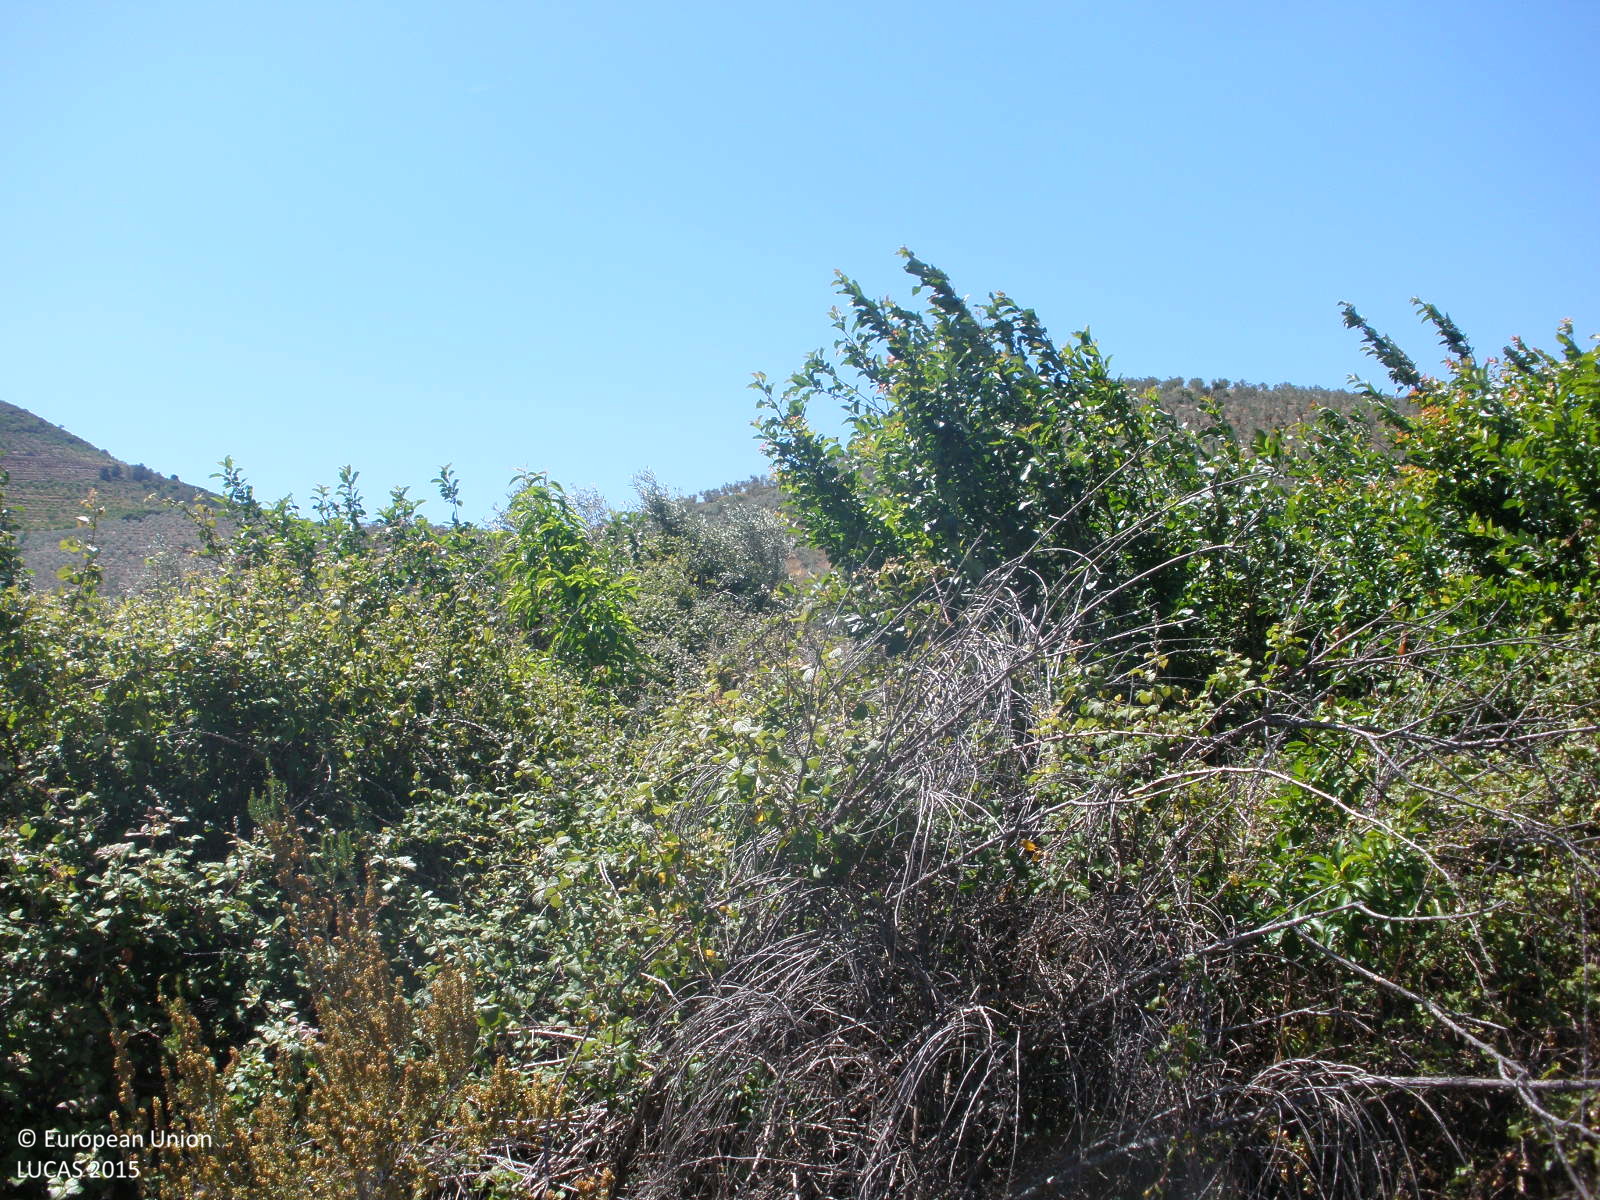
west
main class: Shrubland
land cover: Shrubland without tree cover
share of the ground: > 75 %
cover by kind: shrubs 90 %, herbaceous plants 10 %
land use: Semi-natural and natural areas not in use
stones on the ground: > 50 %
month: May
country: ES
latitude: 40.3196
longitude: -6.1408
